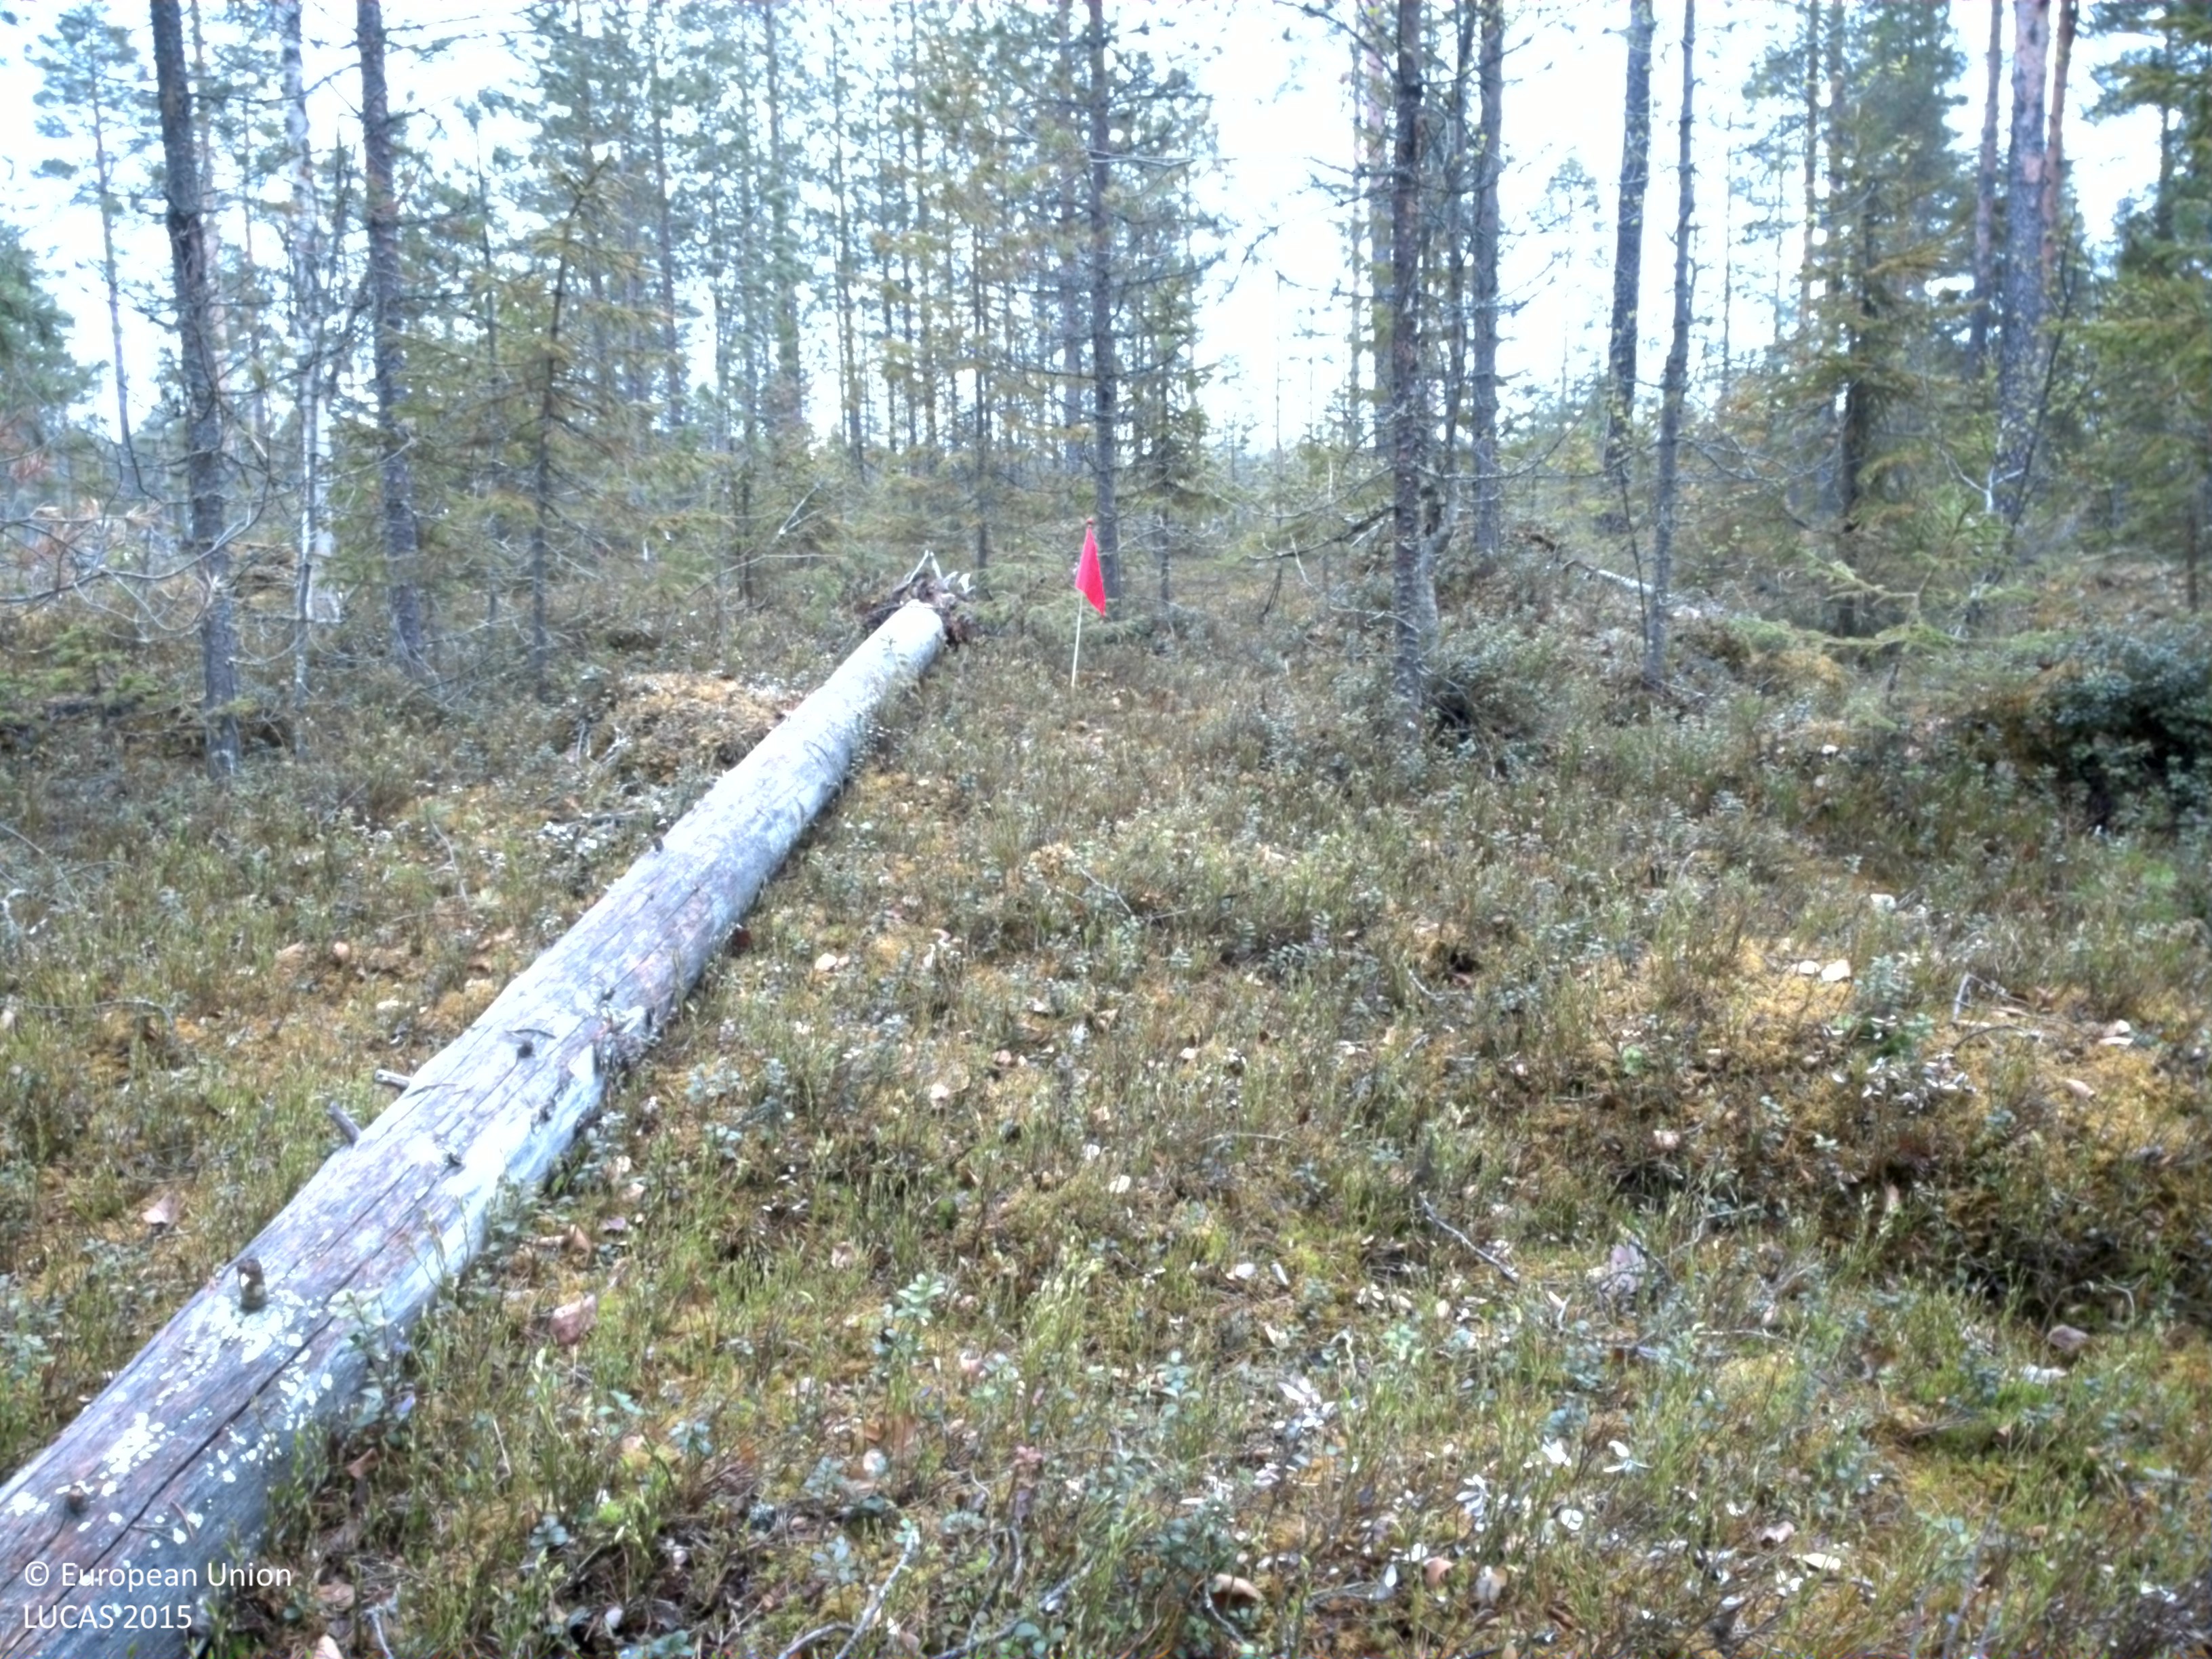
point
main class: Woodland
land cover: Pine dominated coniferous woodland
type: boreal forest
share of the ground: 50 - 75 %
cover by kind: coniferous forest trees 70 %, shrubs 30 %
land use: Forestry
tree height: > 5 m
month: June
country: SE
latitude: 65.8933
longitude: 23.0859
